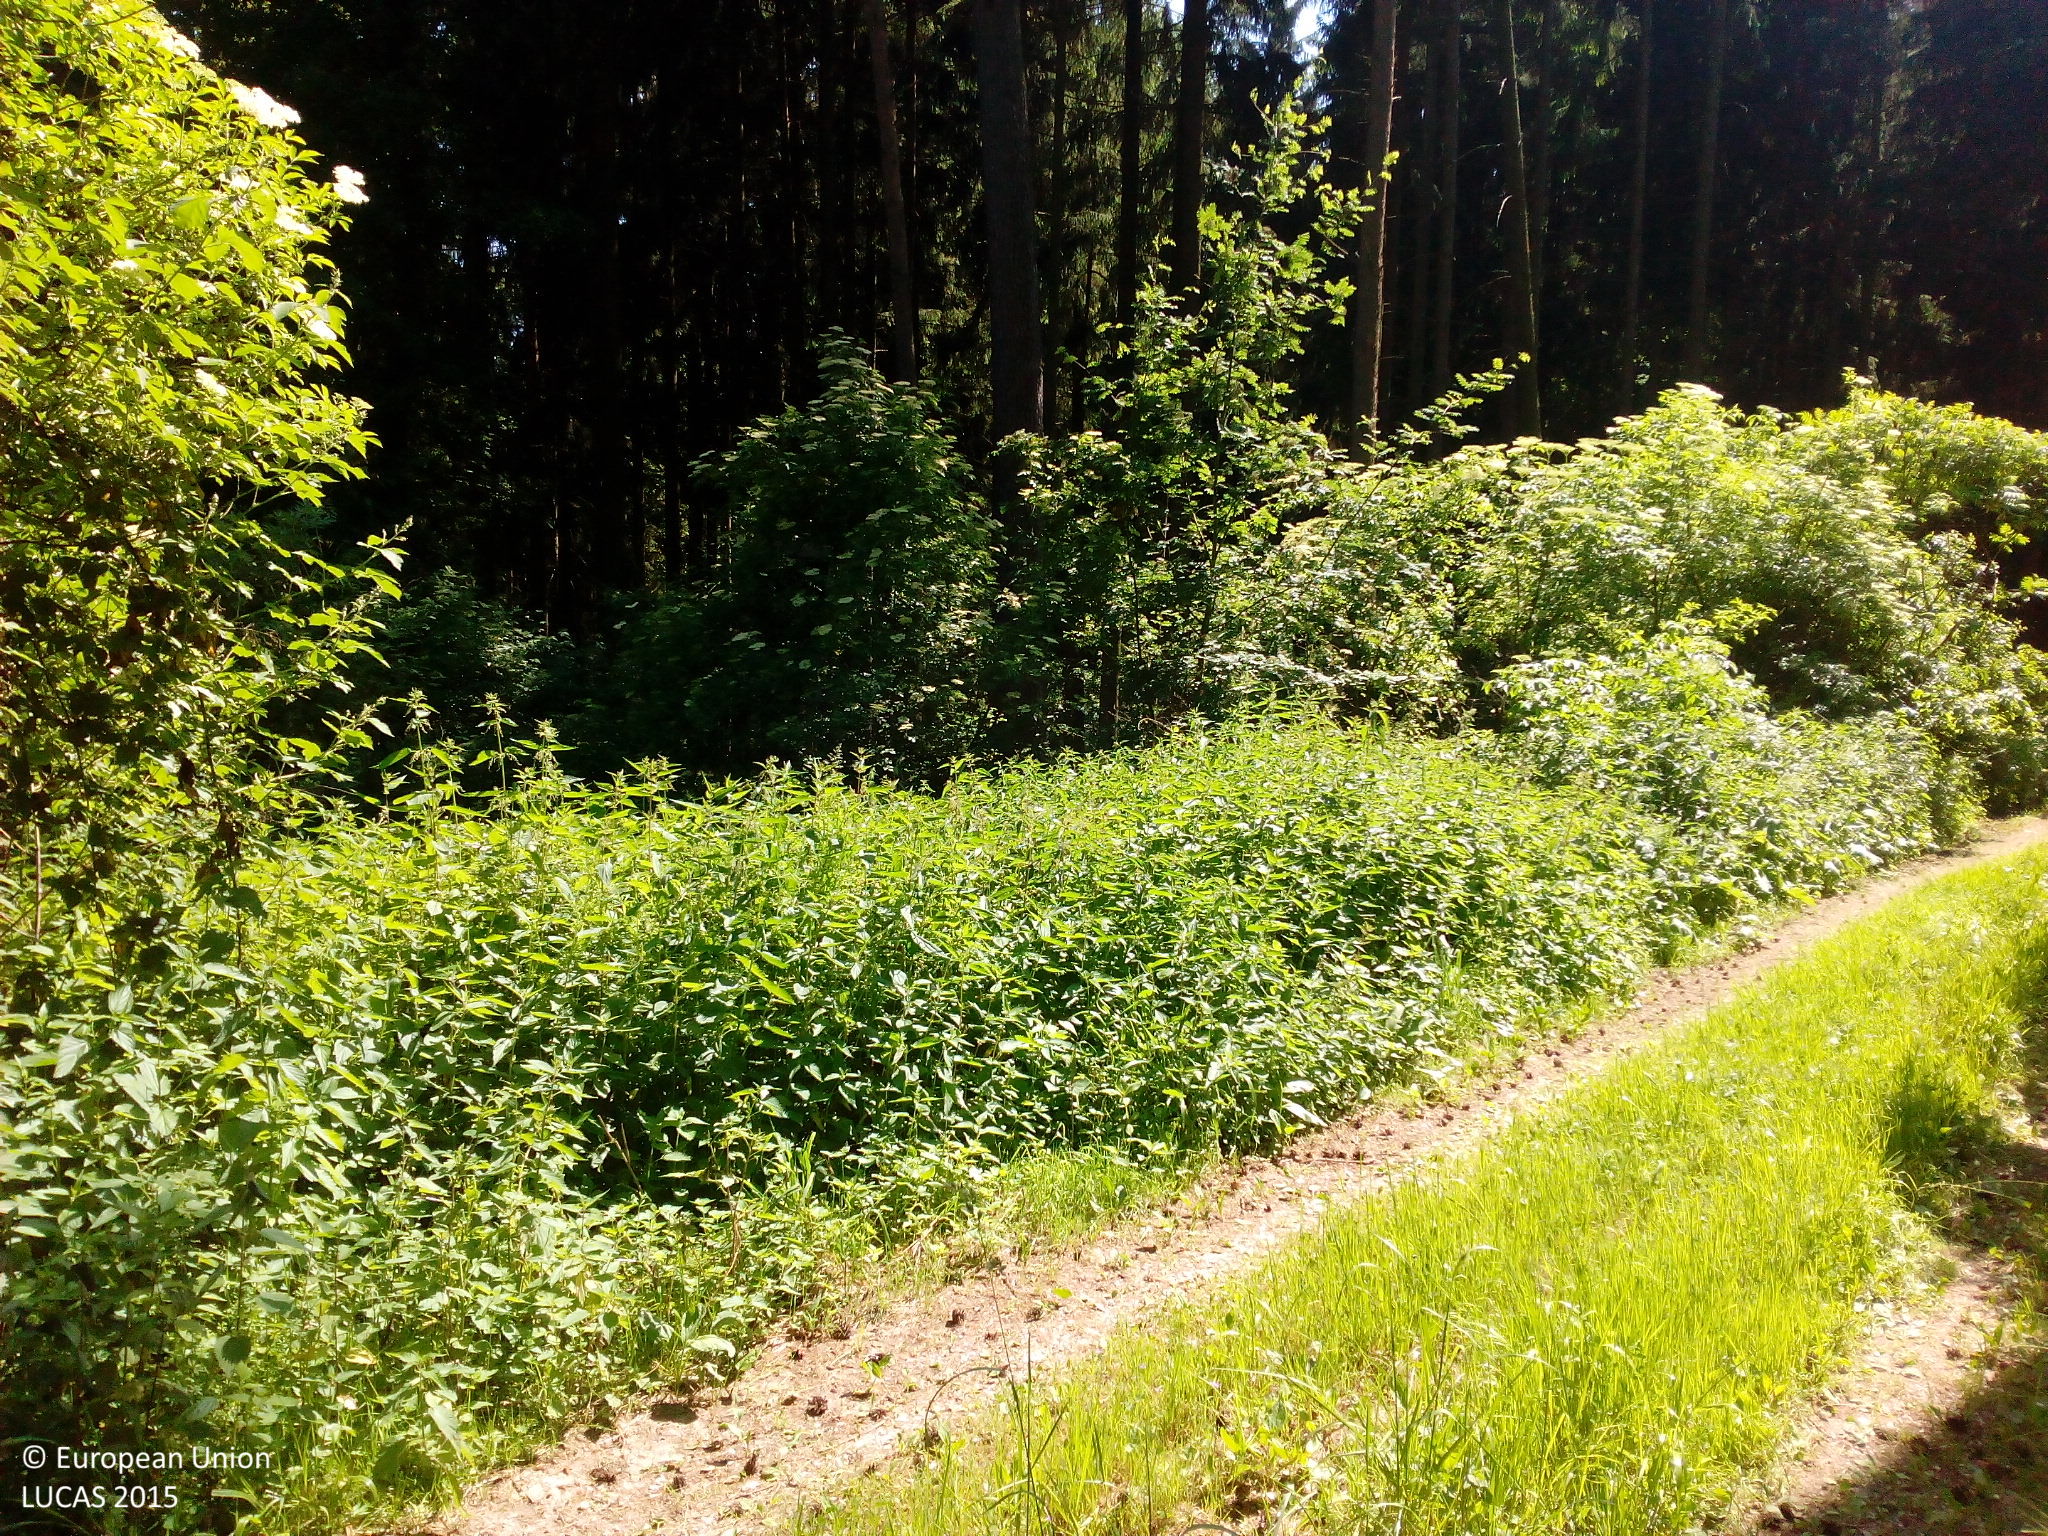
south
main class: Woodland
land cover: Spruce dominated mixed woodland
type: hemiboreal forest and nemoral coniferous forest and mixed broadleaved-coniferous forest
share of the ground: 50 - 75 %
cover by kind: coniferous forest trees 35 %, herbaceous plants 35 %, broadleaved forest trees 20 %, shrubs 10 %
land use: Forestry
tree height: > 5 m
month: June
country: DE
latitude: 48.7913
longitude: 12.4086
